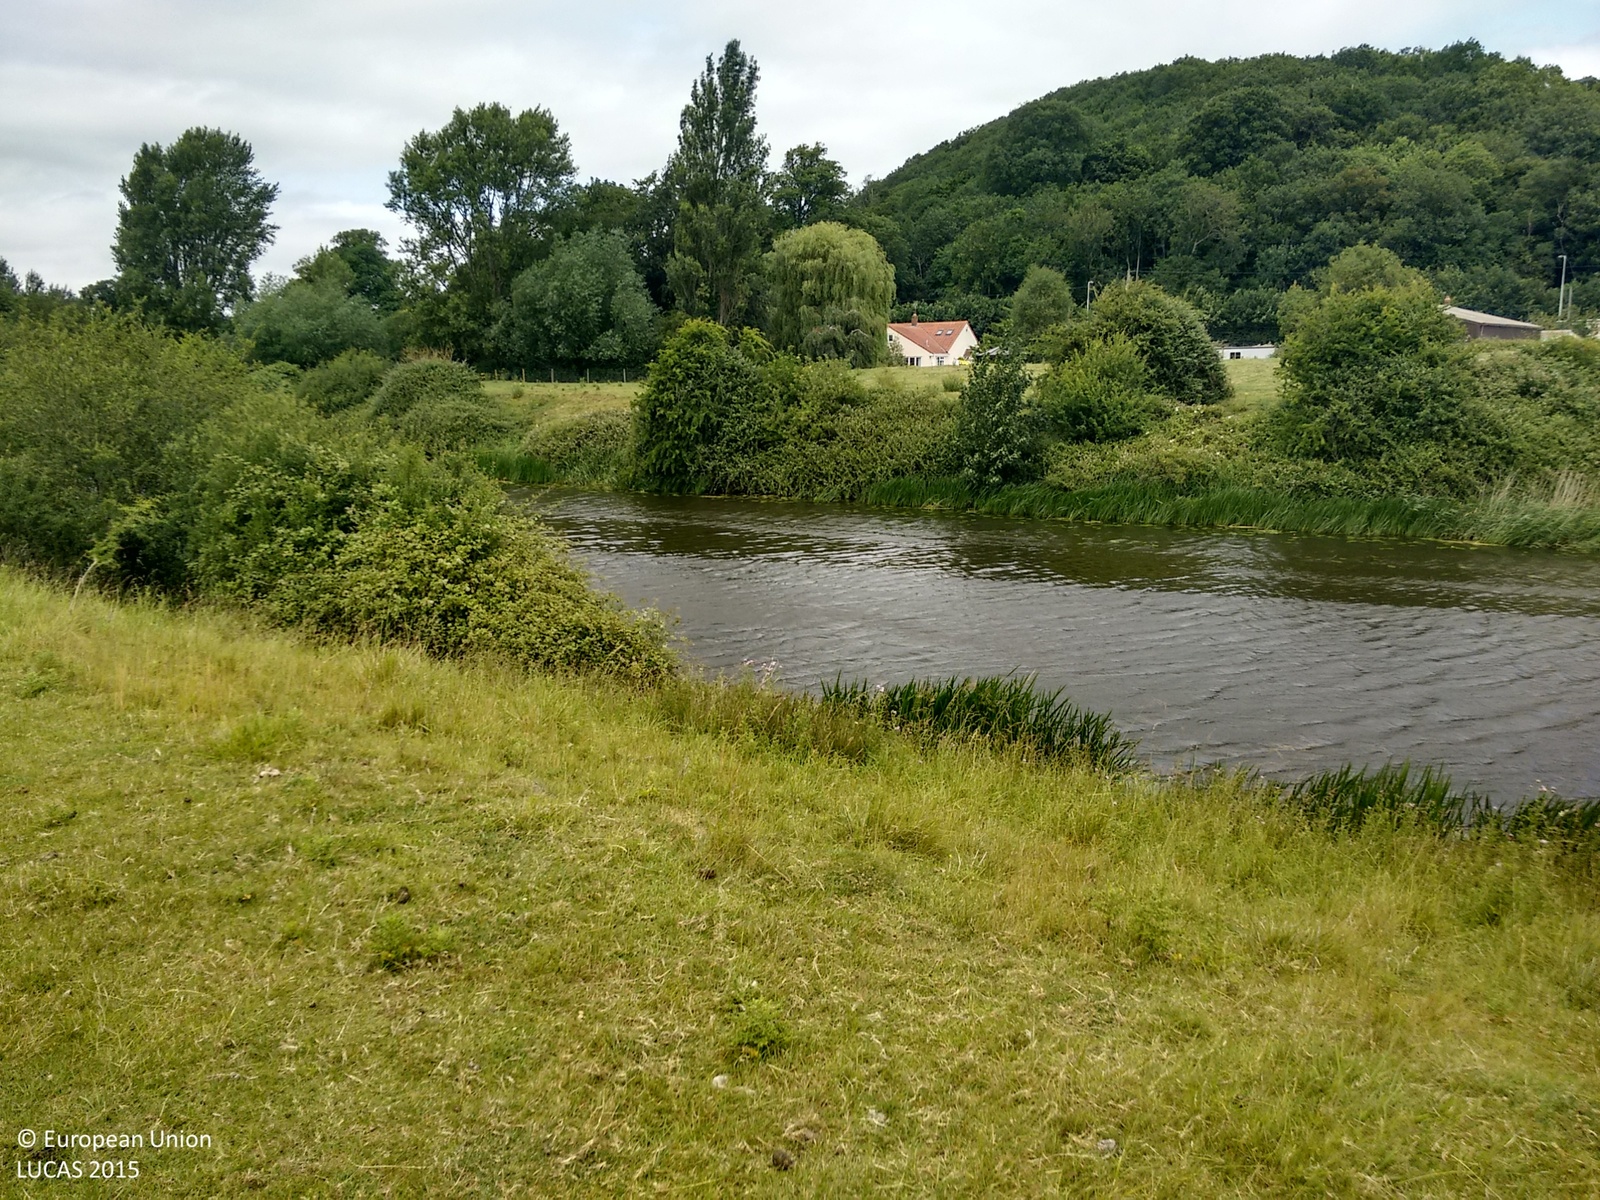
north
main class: Grassland
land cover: Grassland without tree/shrub cover
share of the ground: > 75 %
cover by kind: herbaceous plants 100 %
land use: Agriculture (excluding fallow land and kitchen gardens)
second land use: Amenities, museums, leisure
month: July
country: GB
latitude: 51.1535
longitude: -2.9558
